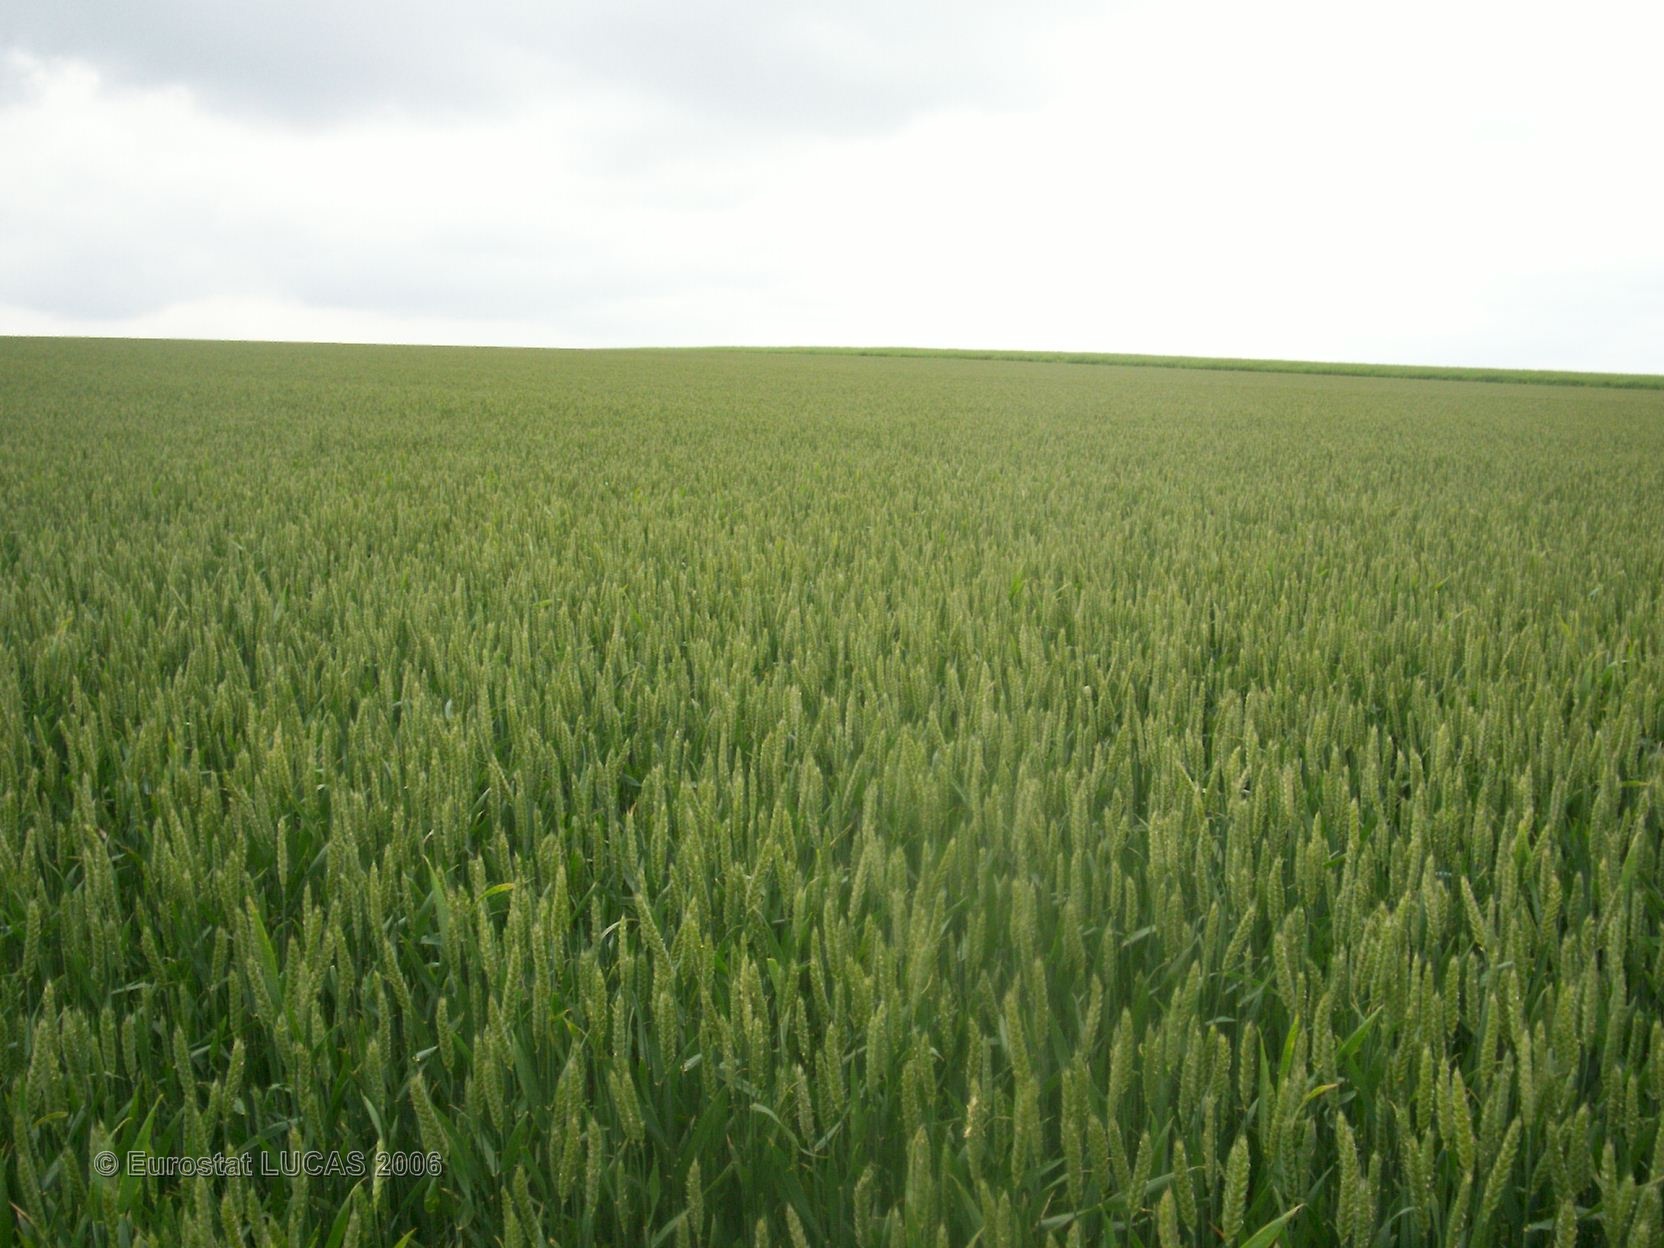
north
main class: Cropland
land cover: Common wheat
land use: Agriculture (excluding fallow land and kitchen gardens)
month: June
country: FR
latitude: 48.5875
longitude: 4.4250
